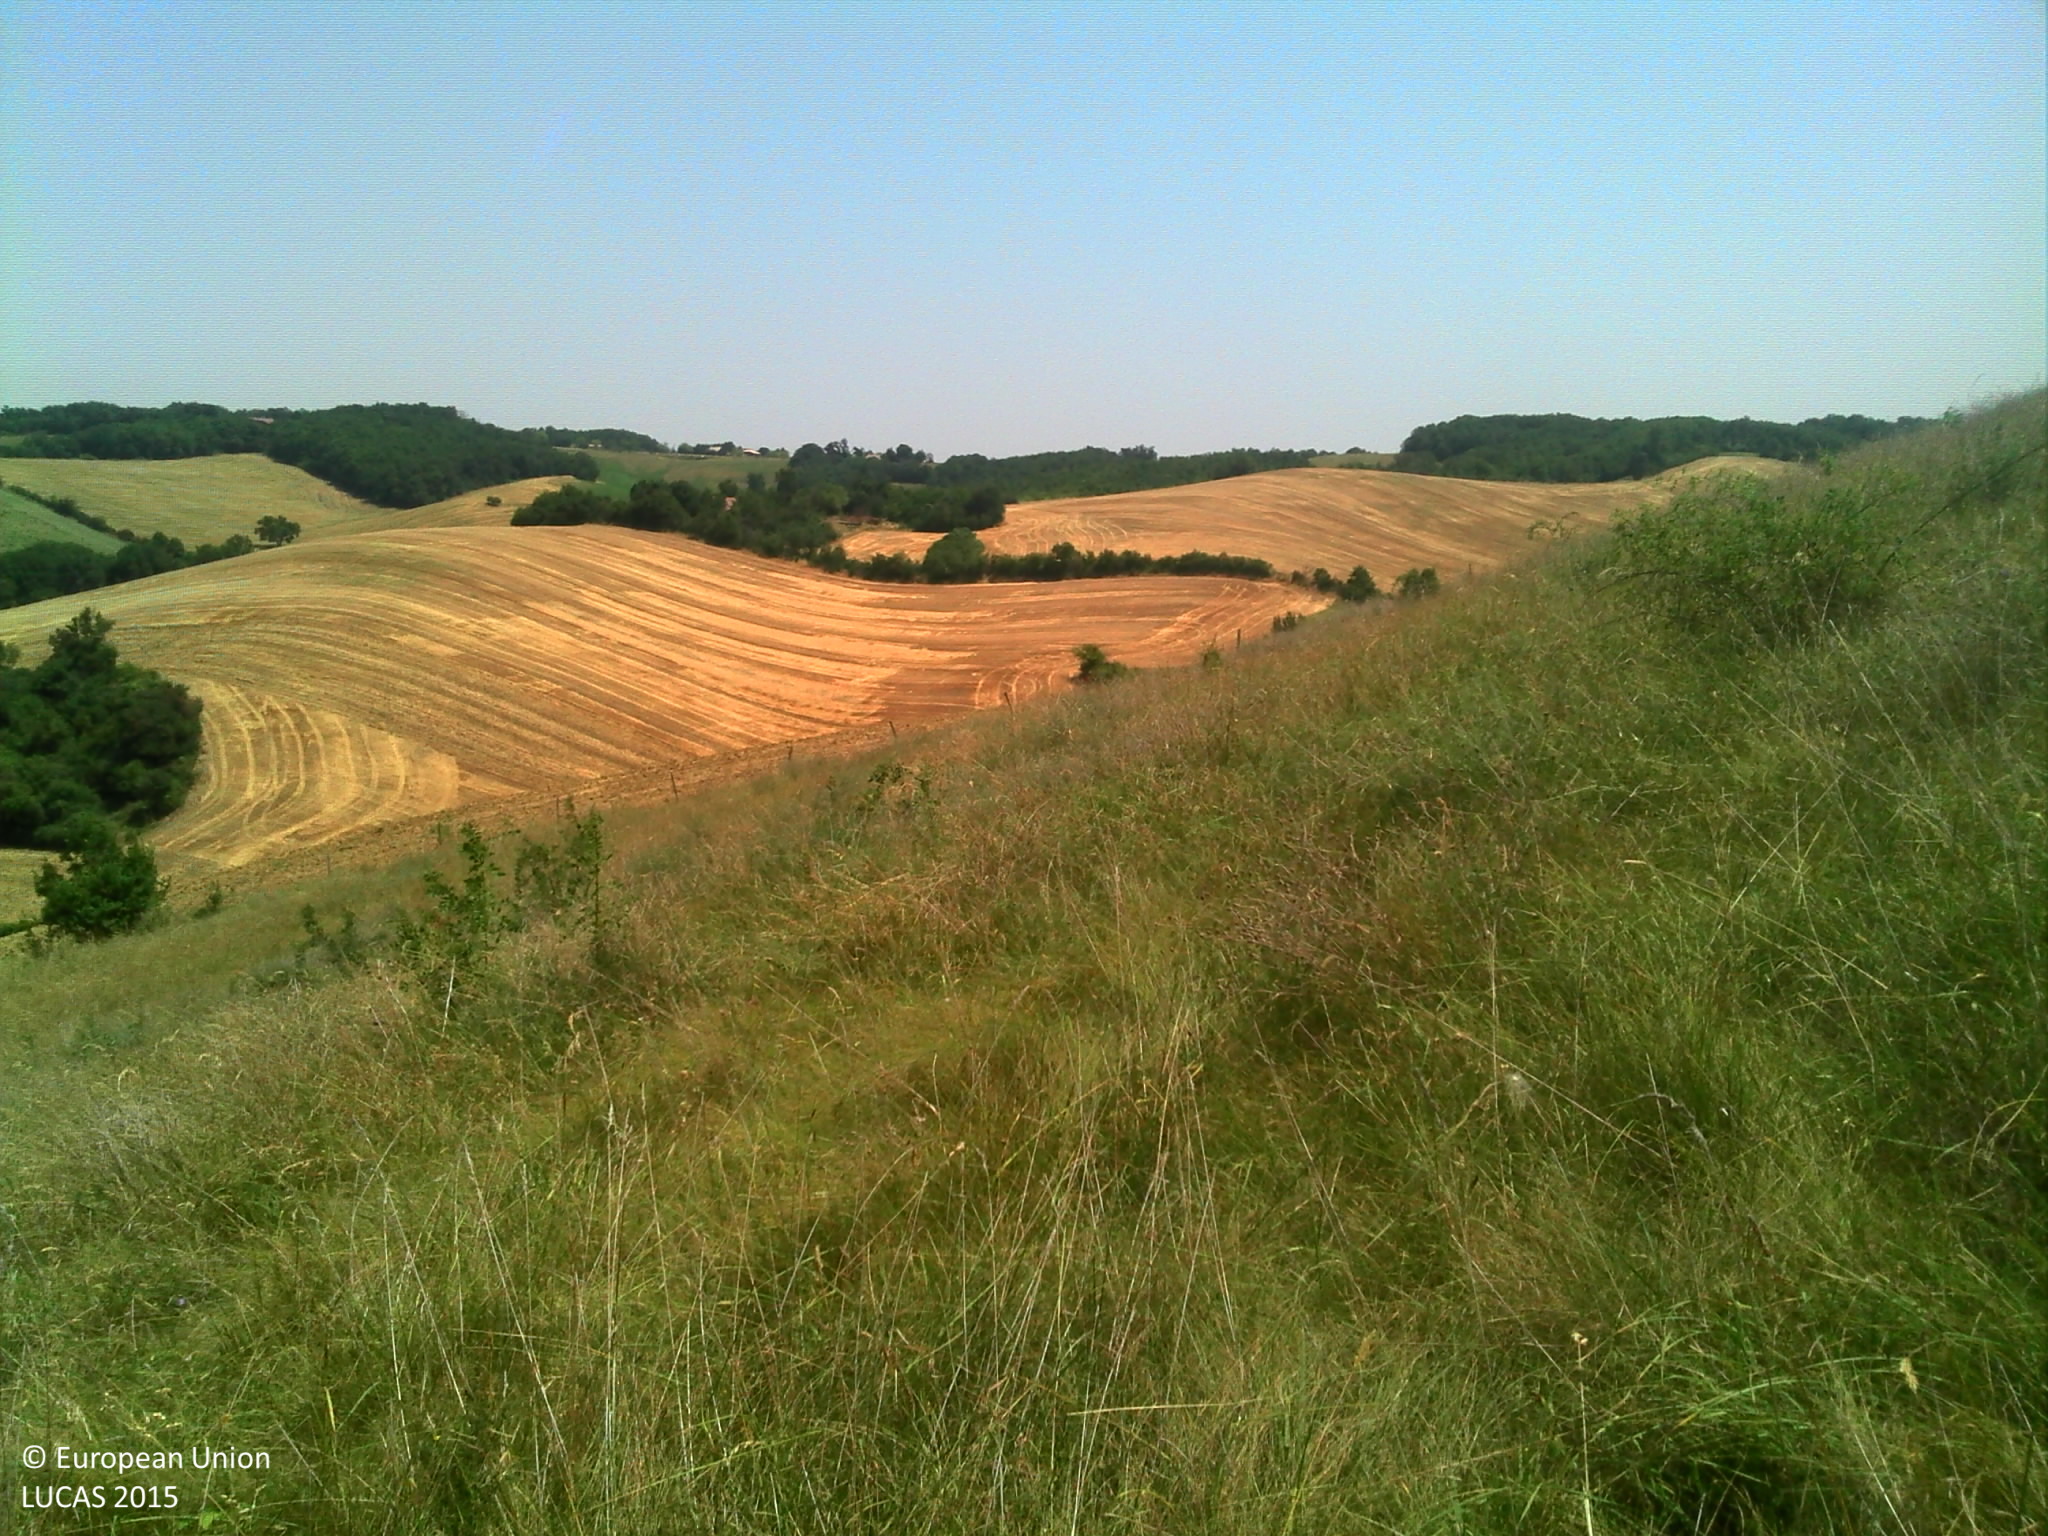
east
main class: Grassland
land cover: Grassland with sparse tree/shrub cover
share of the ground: > 75 %
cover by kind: herbaceous plants 95 %, broadleaved forest trees 5 %
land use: Agriculture (excluding fallow land and kitchen gardens)
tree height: < 5 m
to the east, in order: Grassland with sparse tree/shrub cover; Fences; Other bare soil
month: July
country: FR
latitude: 43.3270
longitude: 1.0366
